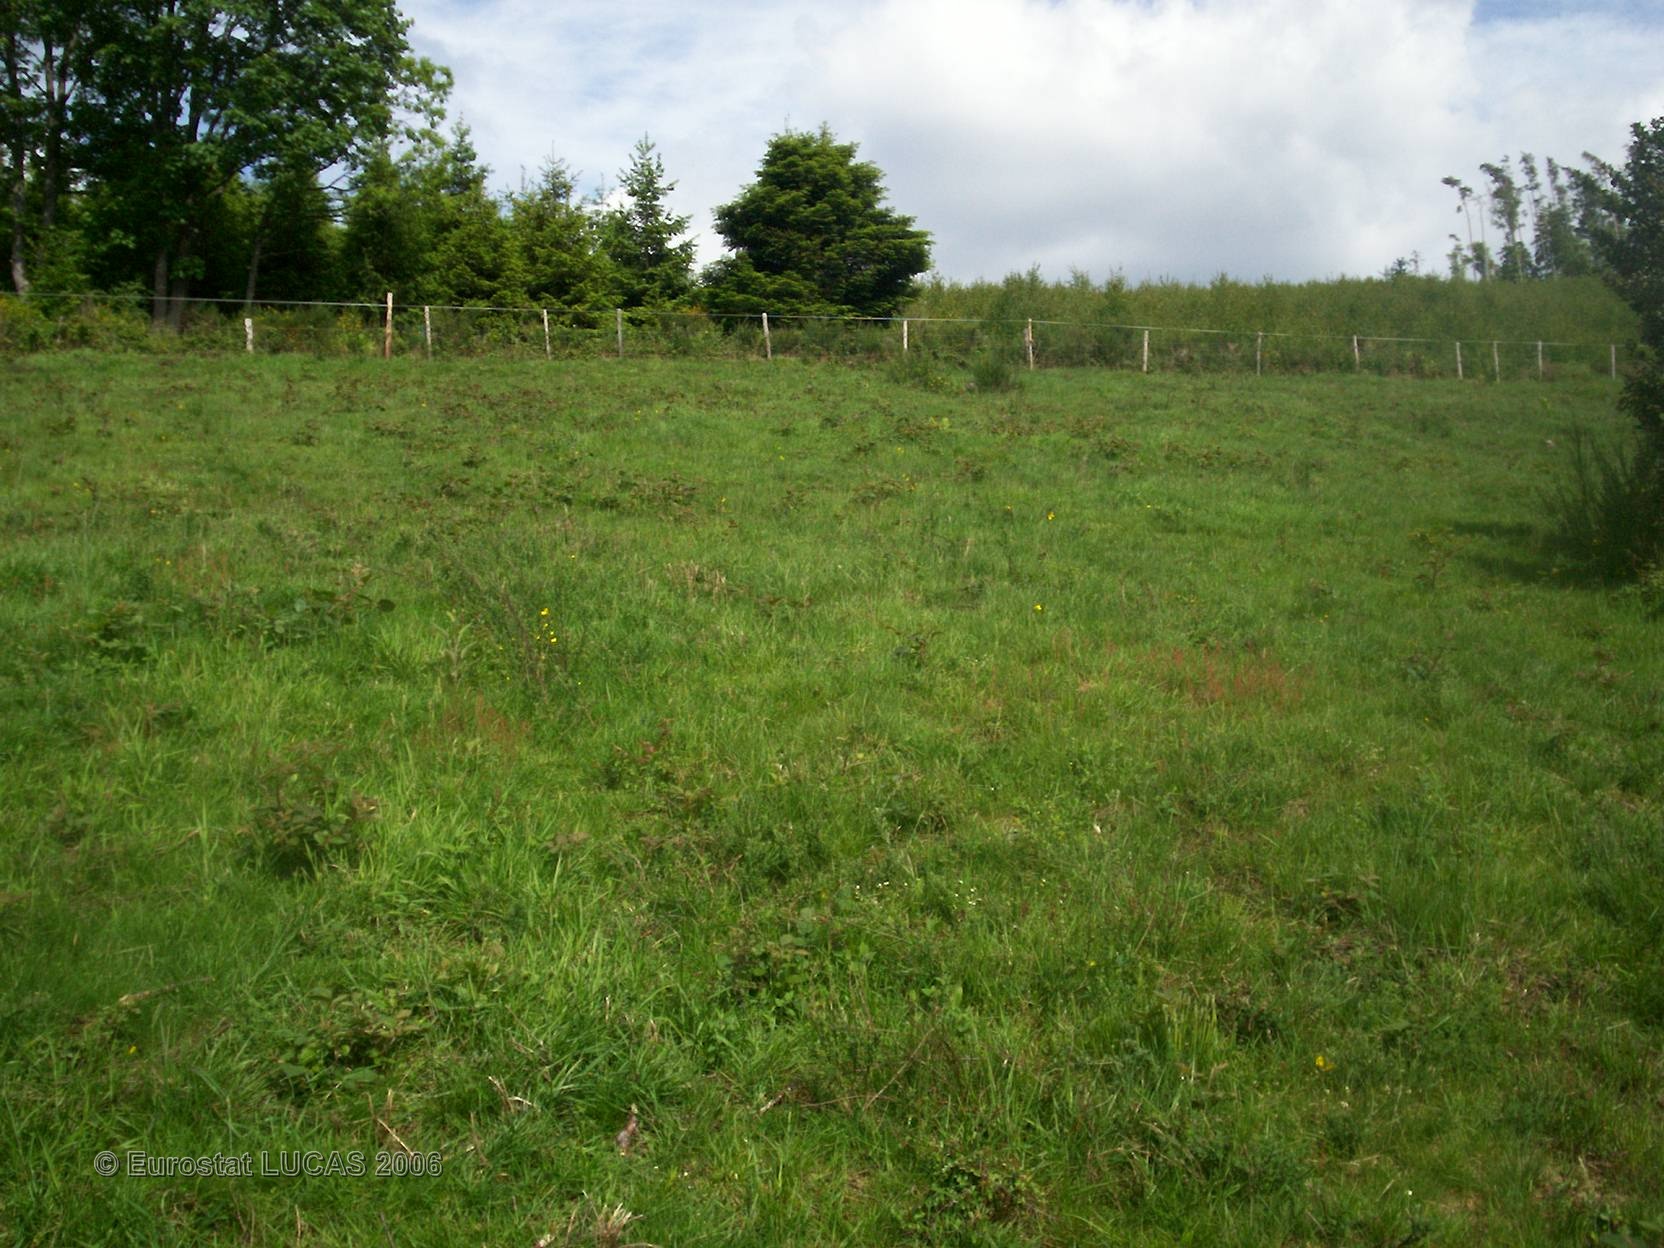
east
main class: Grassland
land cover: Grassland with sparse tree/shrub cover
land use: Agriculture (excluding fallow land and kitchen gardens)
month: June
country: FR
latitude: 48.2209
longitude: 7.0802
